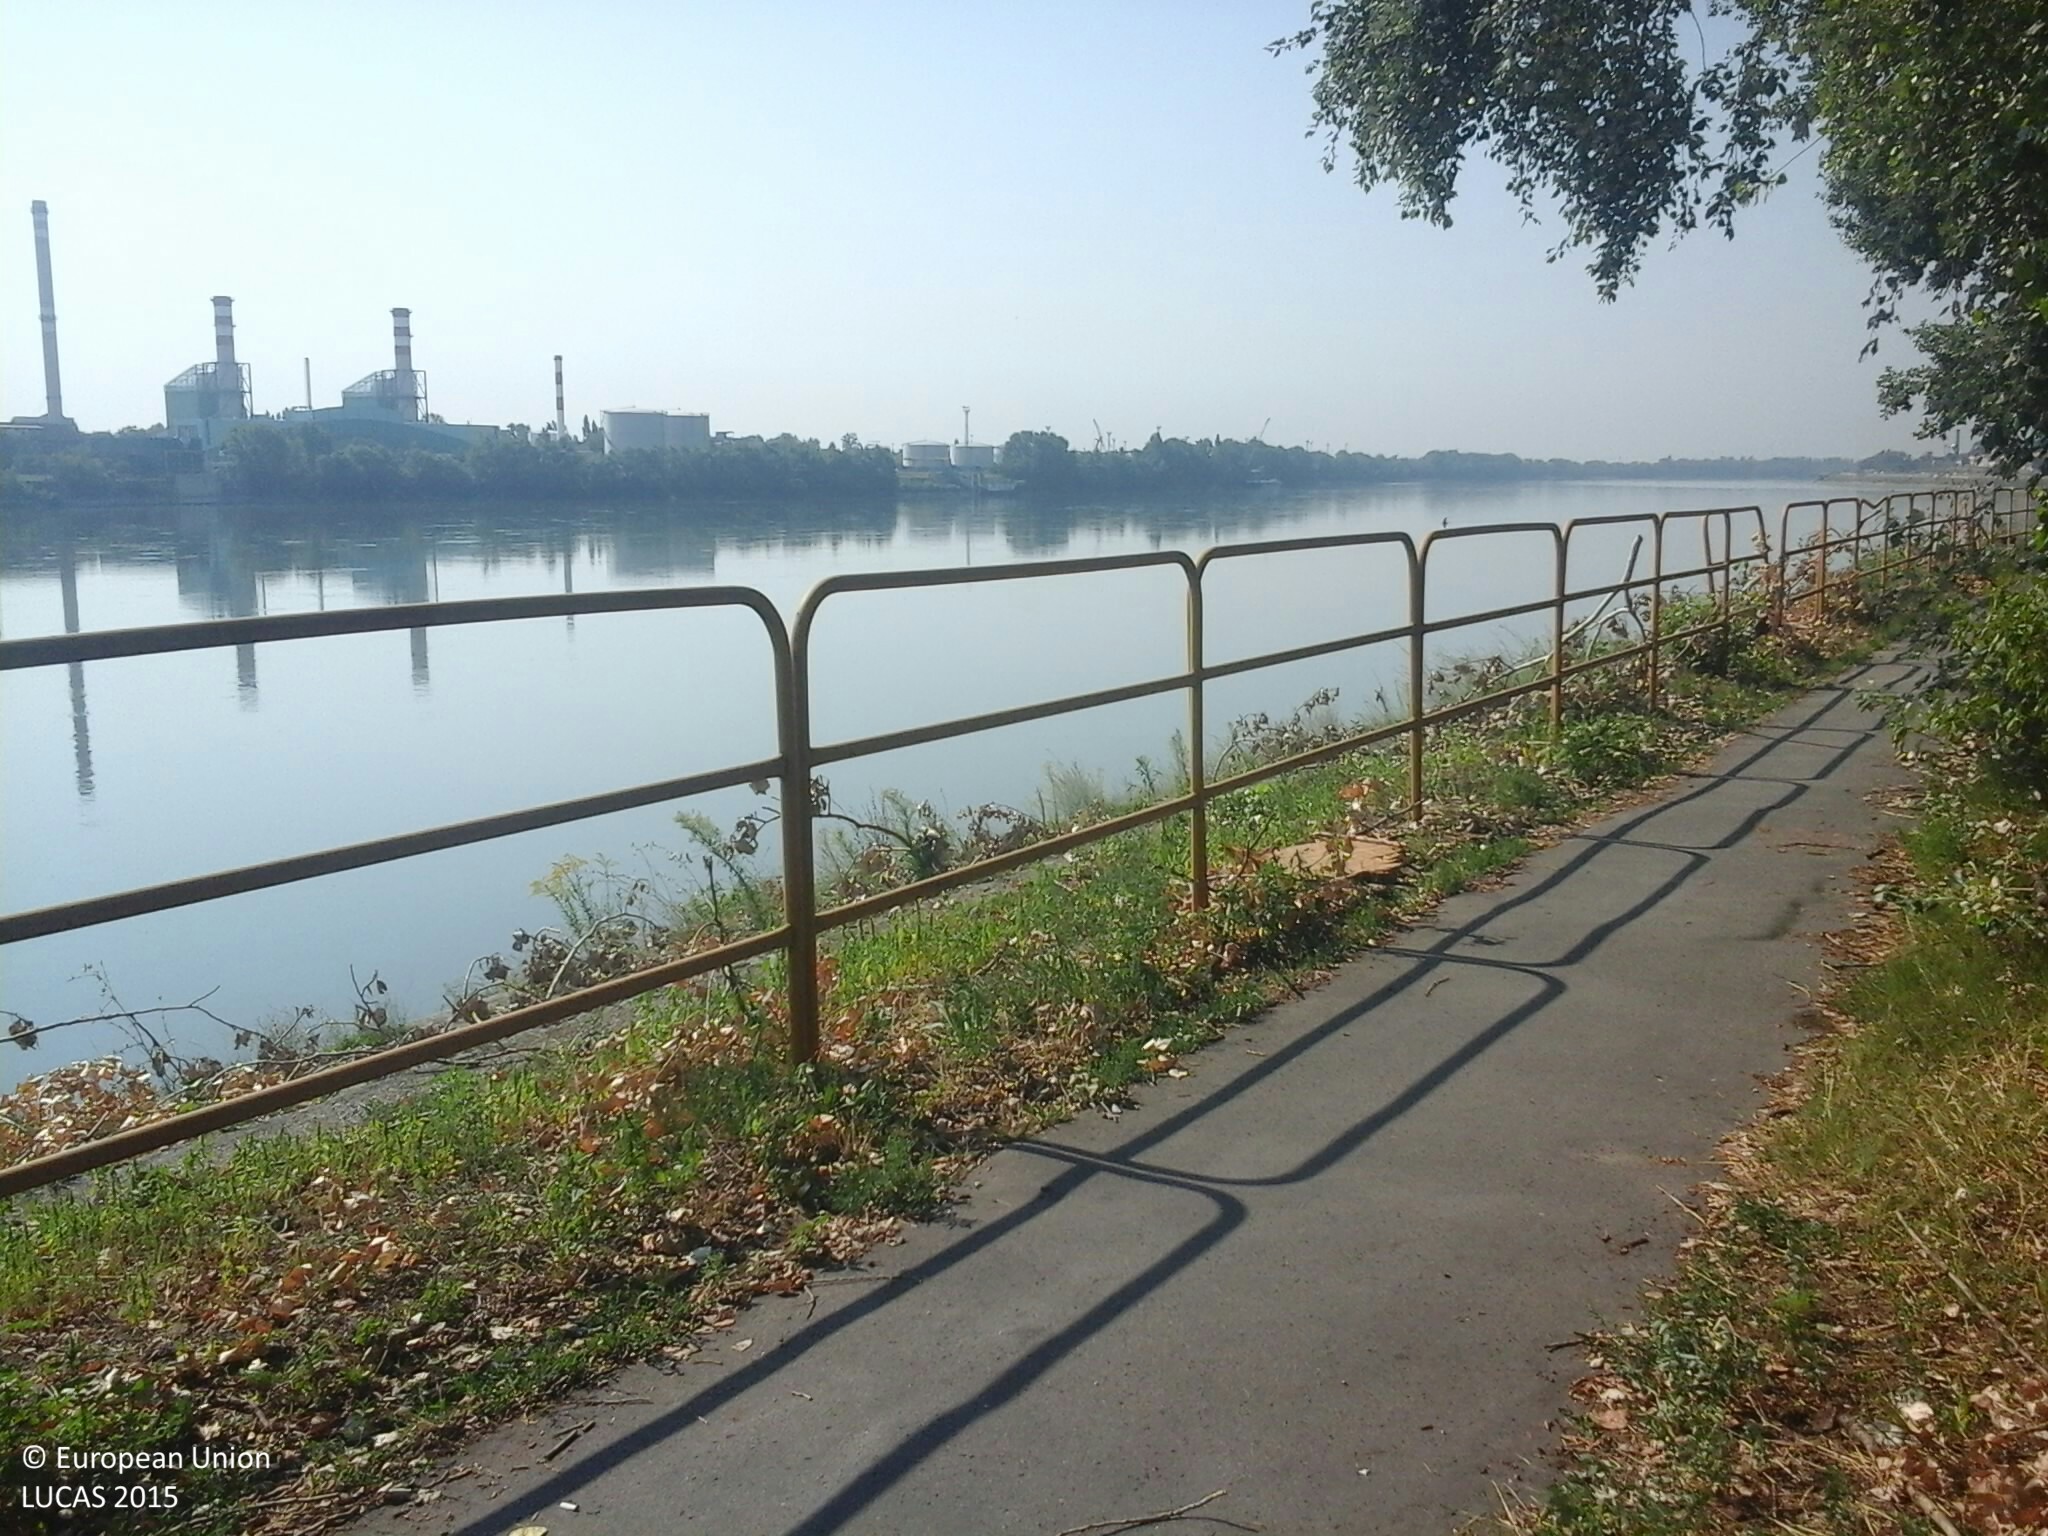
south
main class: Woodland
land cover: Broadleaved woodland
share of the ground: > 75 %
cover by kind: broadleaved forest trees 100 %
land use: Amenities, museums, leisure
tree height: > 5 m
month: August
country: HU
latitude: 47.4345
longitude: 19.0468
